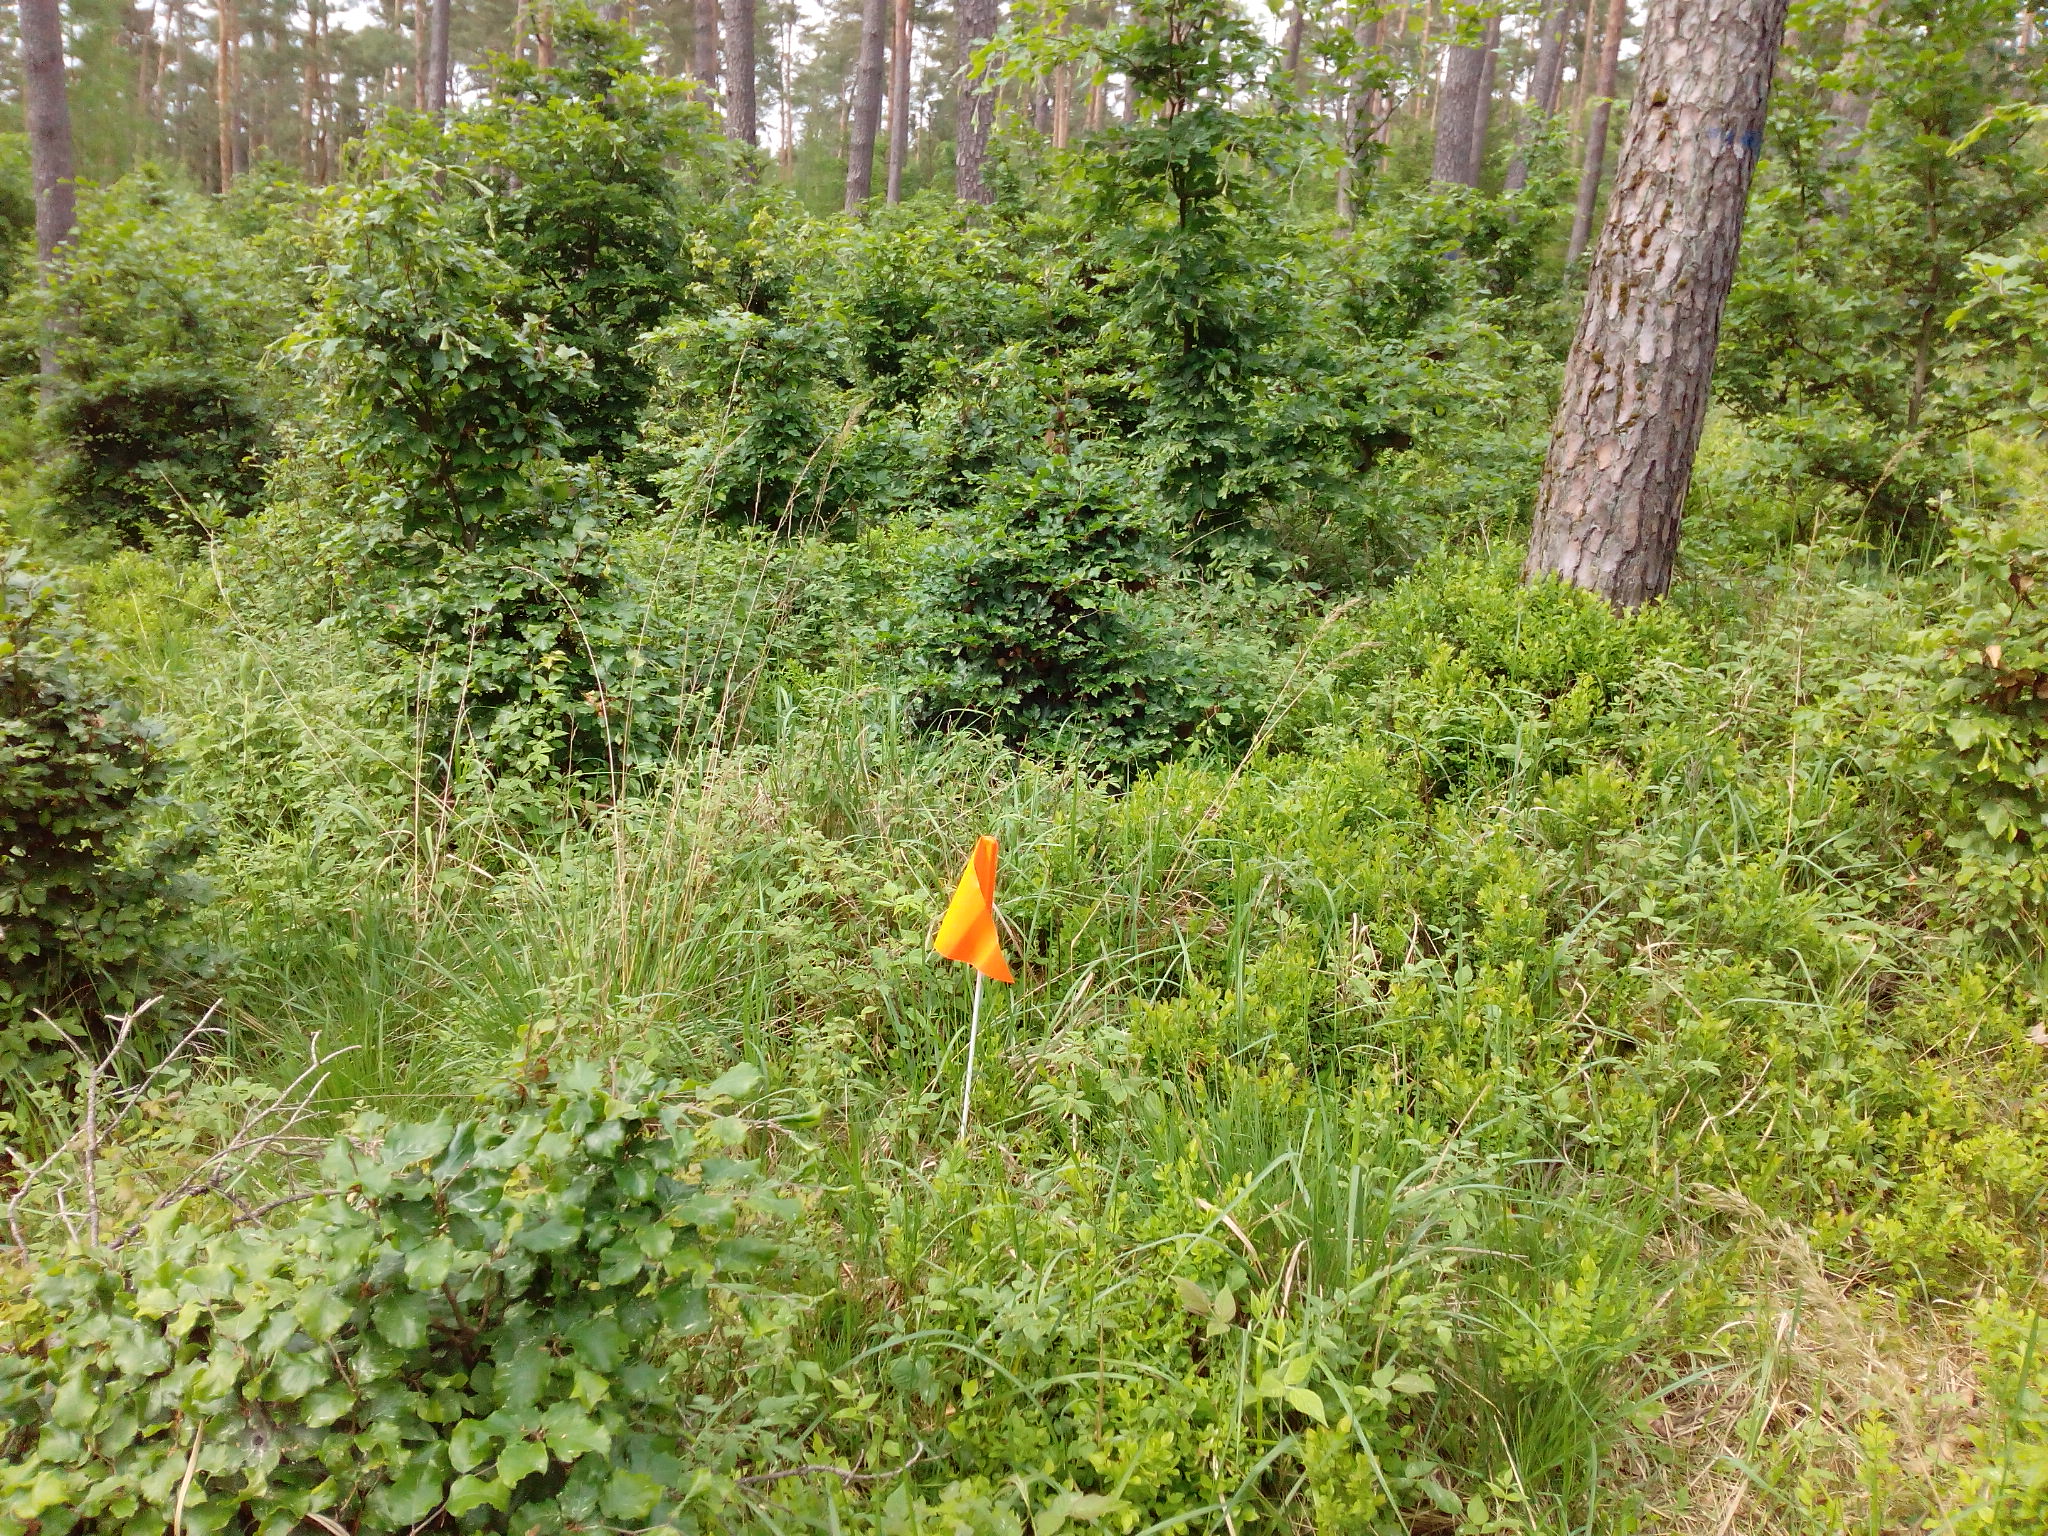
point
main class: Woodland
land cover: Pine dominated mixed woodland
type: hemiboreal forest and nemoral coniferous forest and mixed broadleaved-coniferous forest
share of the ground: > 75 %
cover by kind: coniferous forest trees 50 %, broadleaved forest trees 20 %, shrubs 20 %, herbaceous plants 10 %
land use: Forestry
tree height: > 5 m
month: June
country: DE
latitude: 52.6111
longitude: 9.9262
